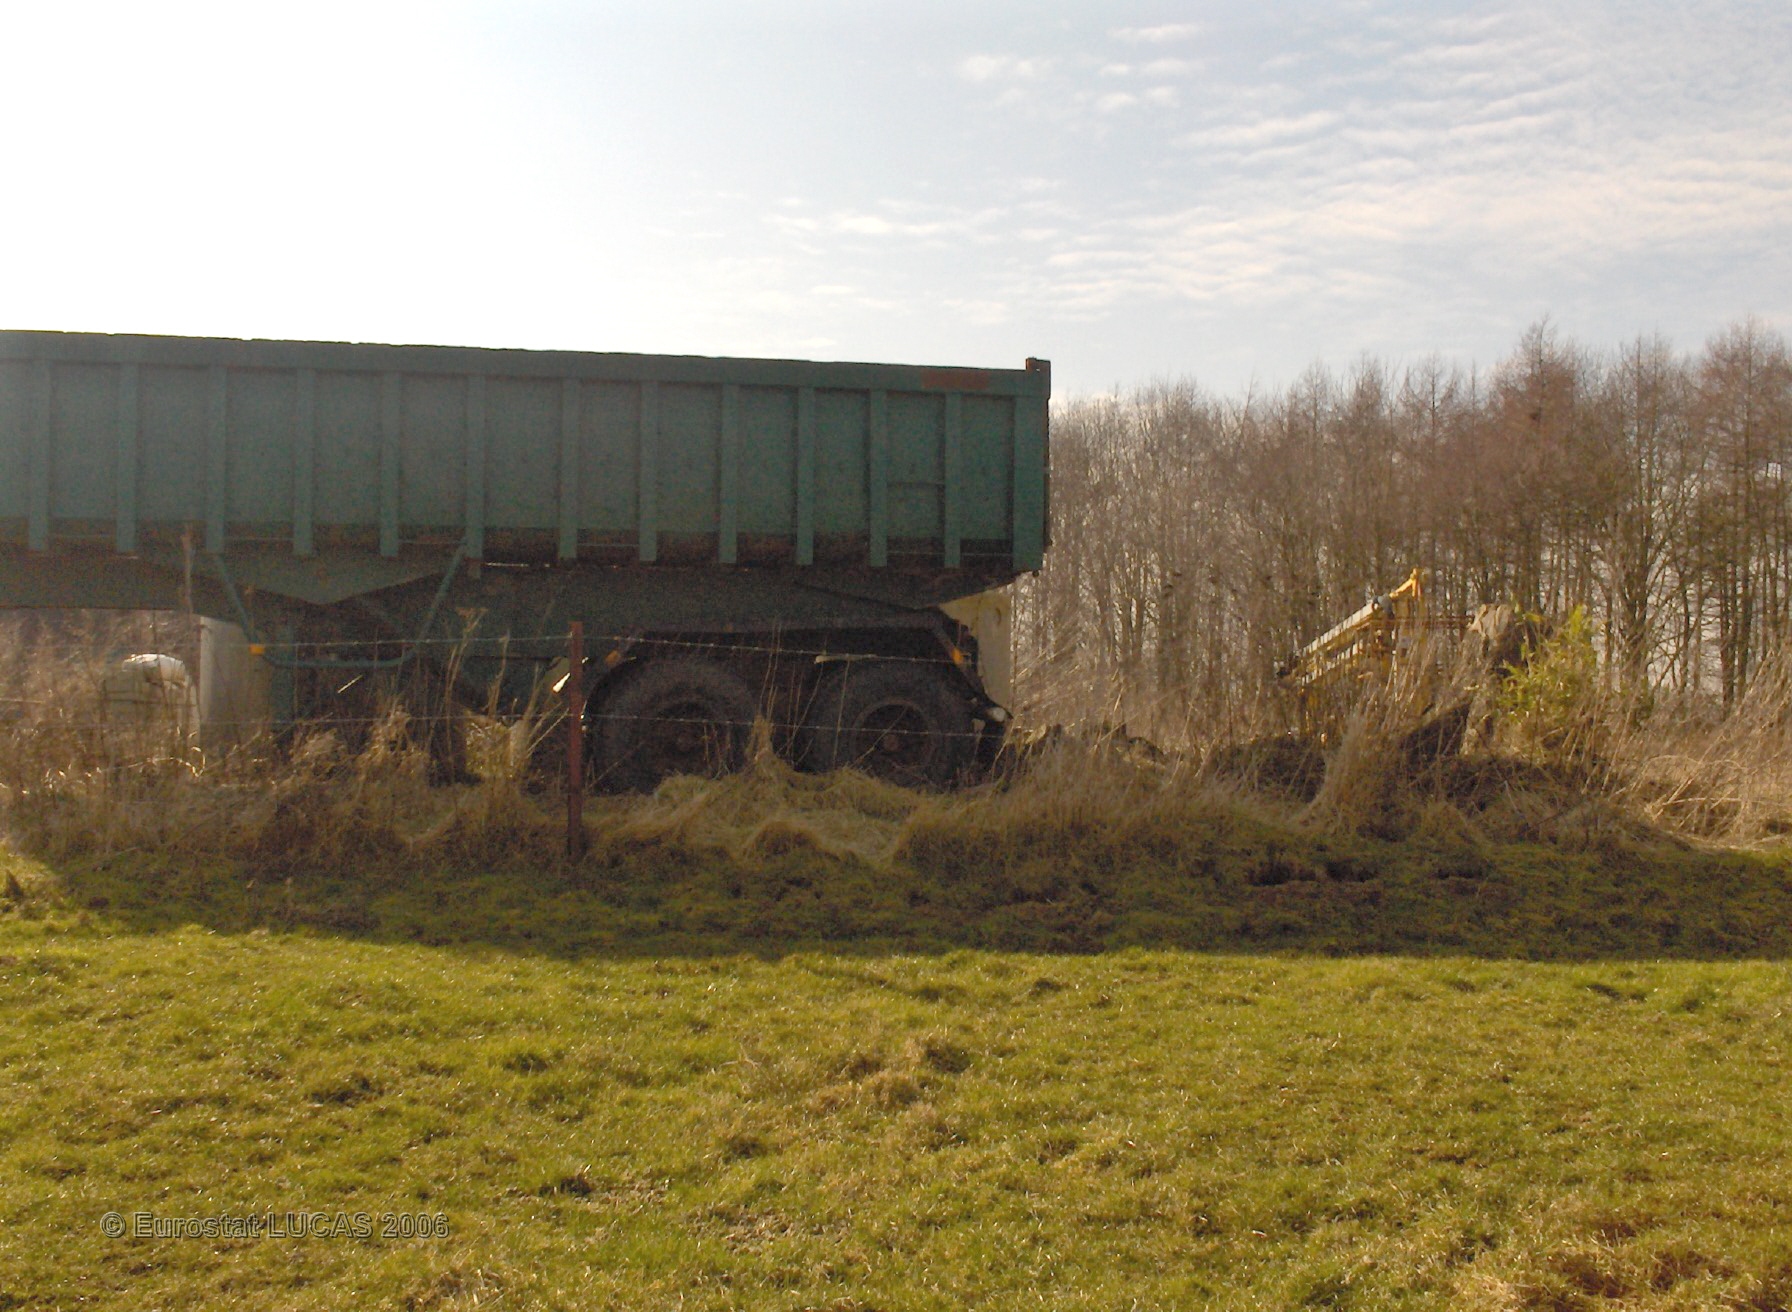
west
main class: Grassland
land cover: Grassland without tree/shrub cover
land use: Agriculture (excluding fallow land and kitchen gardens)
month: March
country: BE
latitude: 50.6268
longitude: 4.4684
